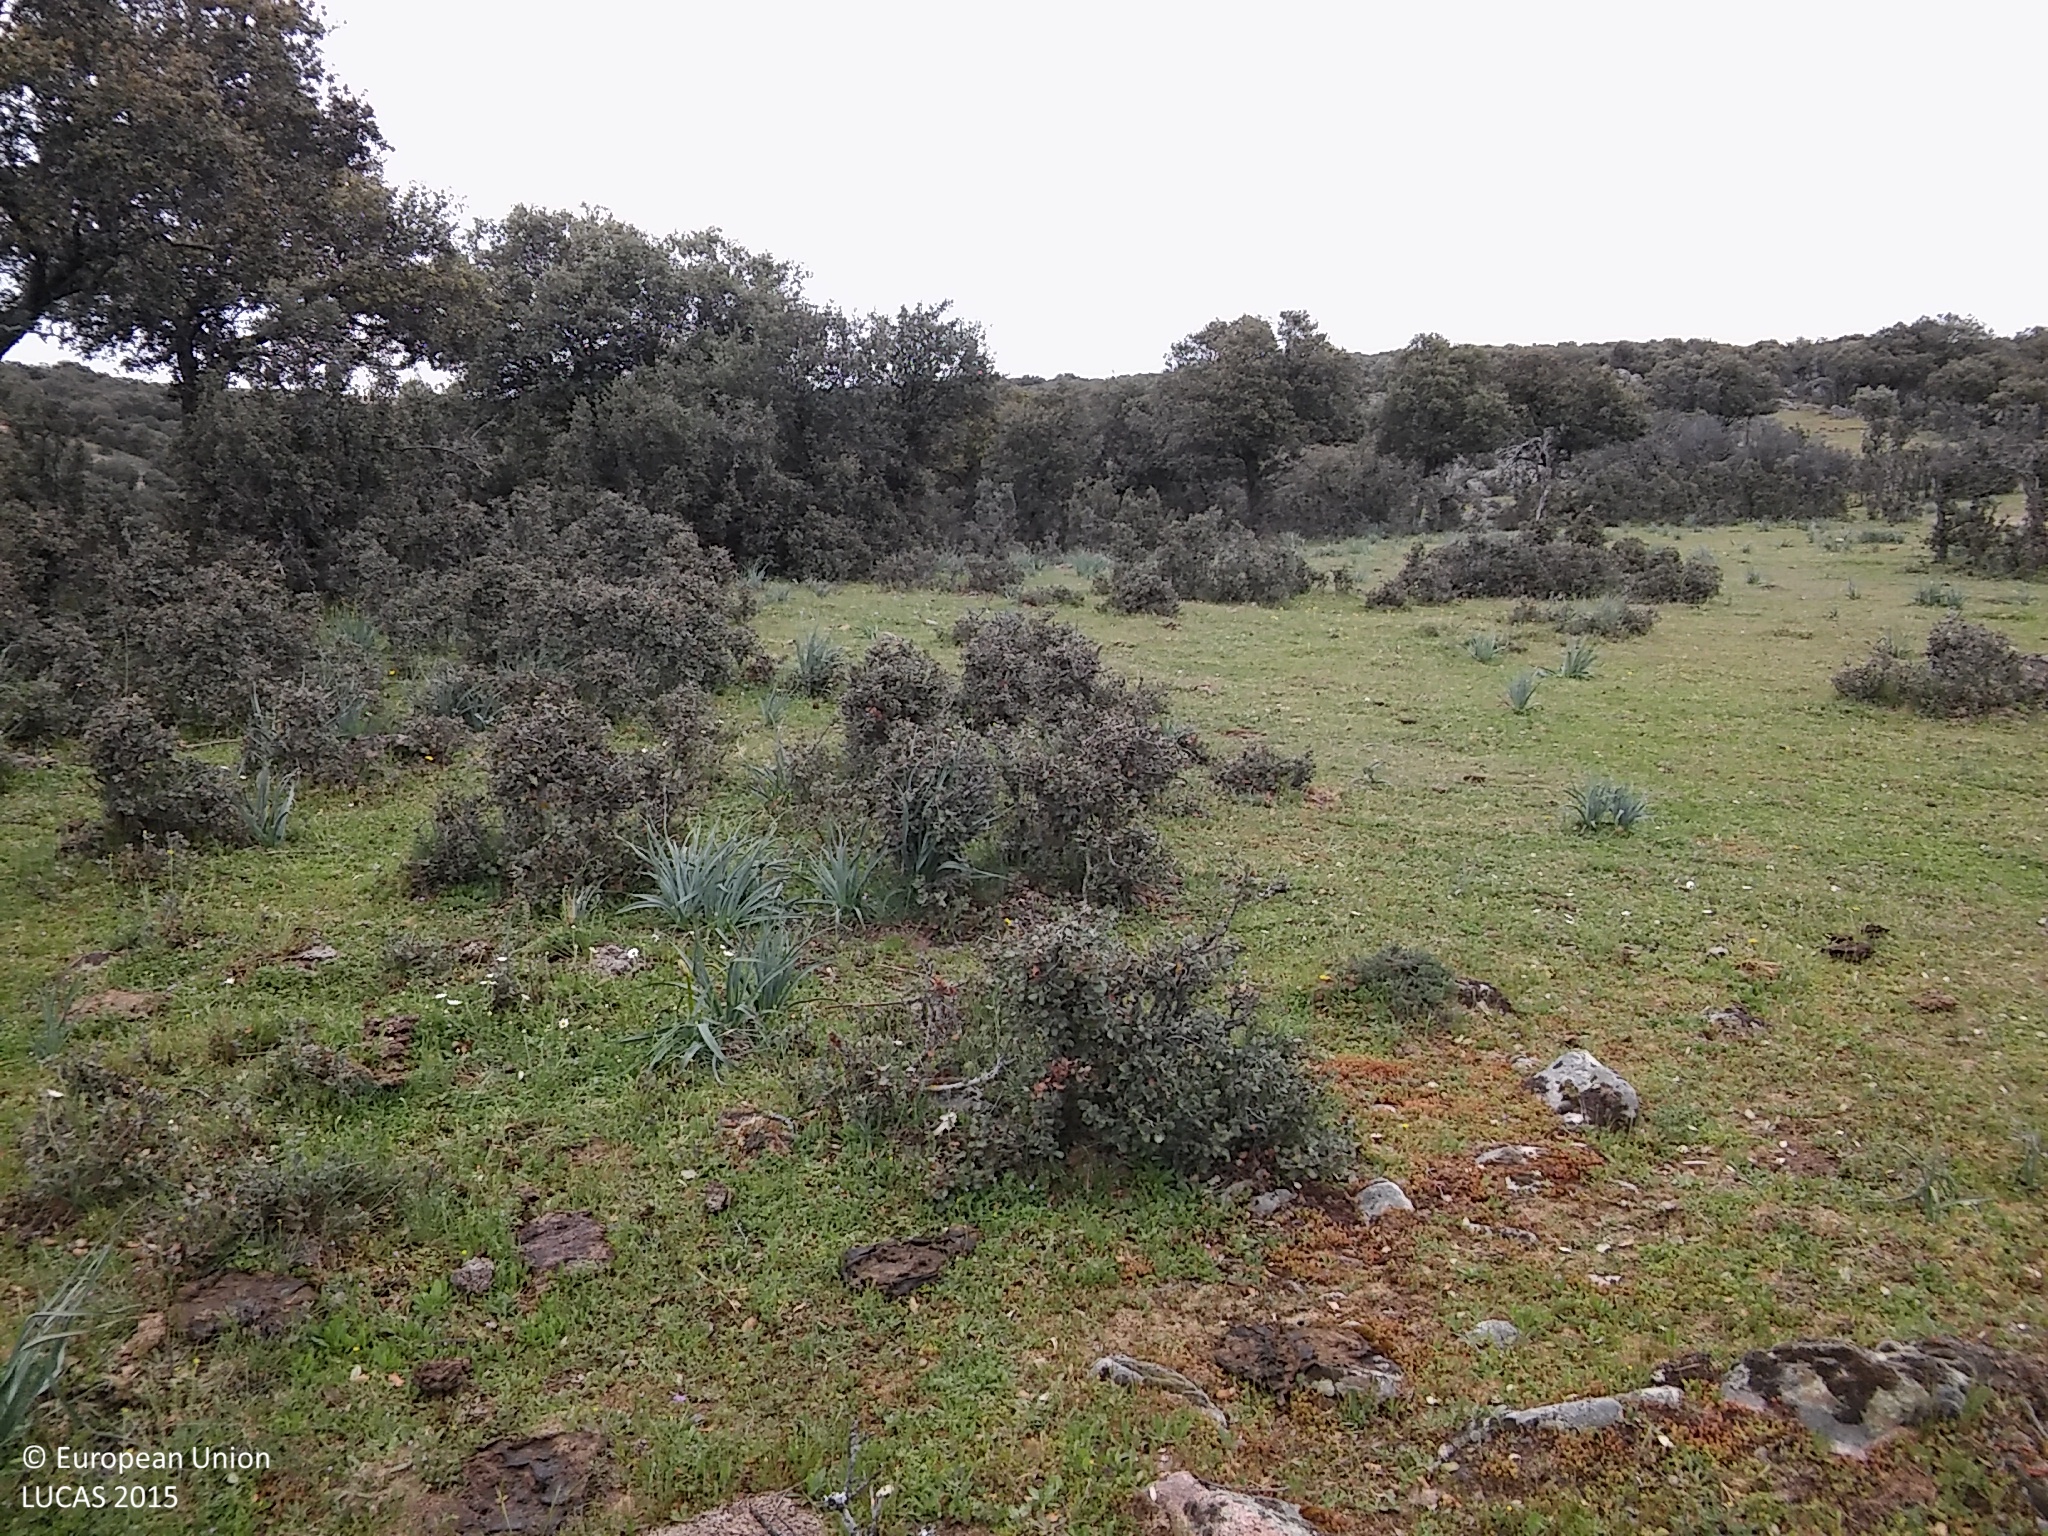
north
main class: Woodland
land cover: Broadleaved woodland
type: broadleaved evergreen forest
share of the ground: 10 - 25 %
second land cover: Shrubland without tree cover
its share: 50 - 75 %
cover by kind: herbaceous plants 60 %, shrubs 25 %, broadleaved forest trees 10 %, unconsolidated bare surface 5 %
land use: Forestry
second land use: Agriculture (excluding fallow land and kitchen gardens)
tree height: > 5 m
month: May
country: ES
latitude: 41.0883
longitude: -4.0144
